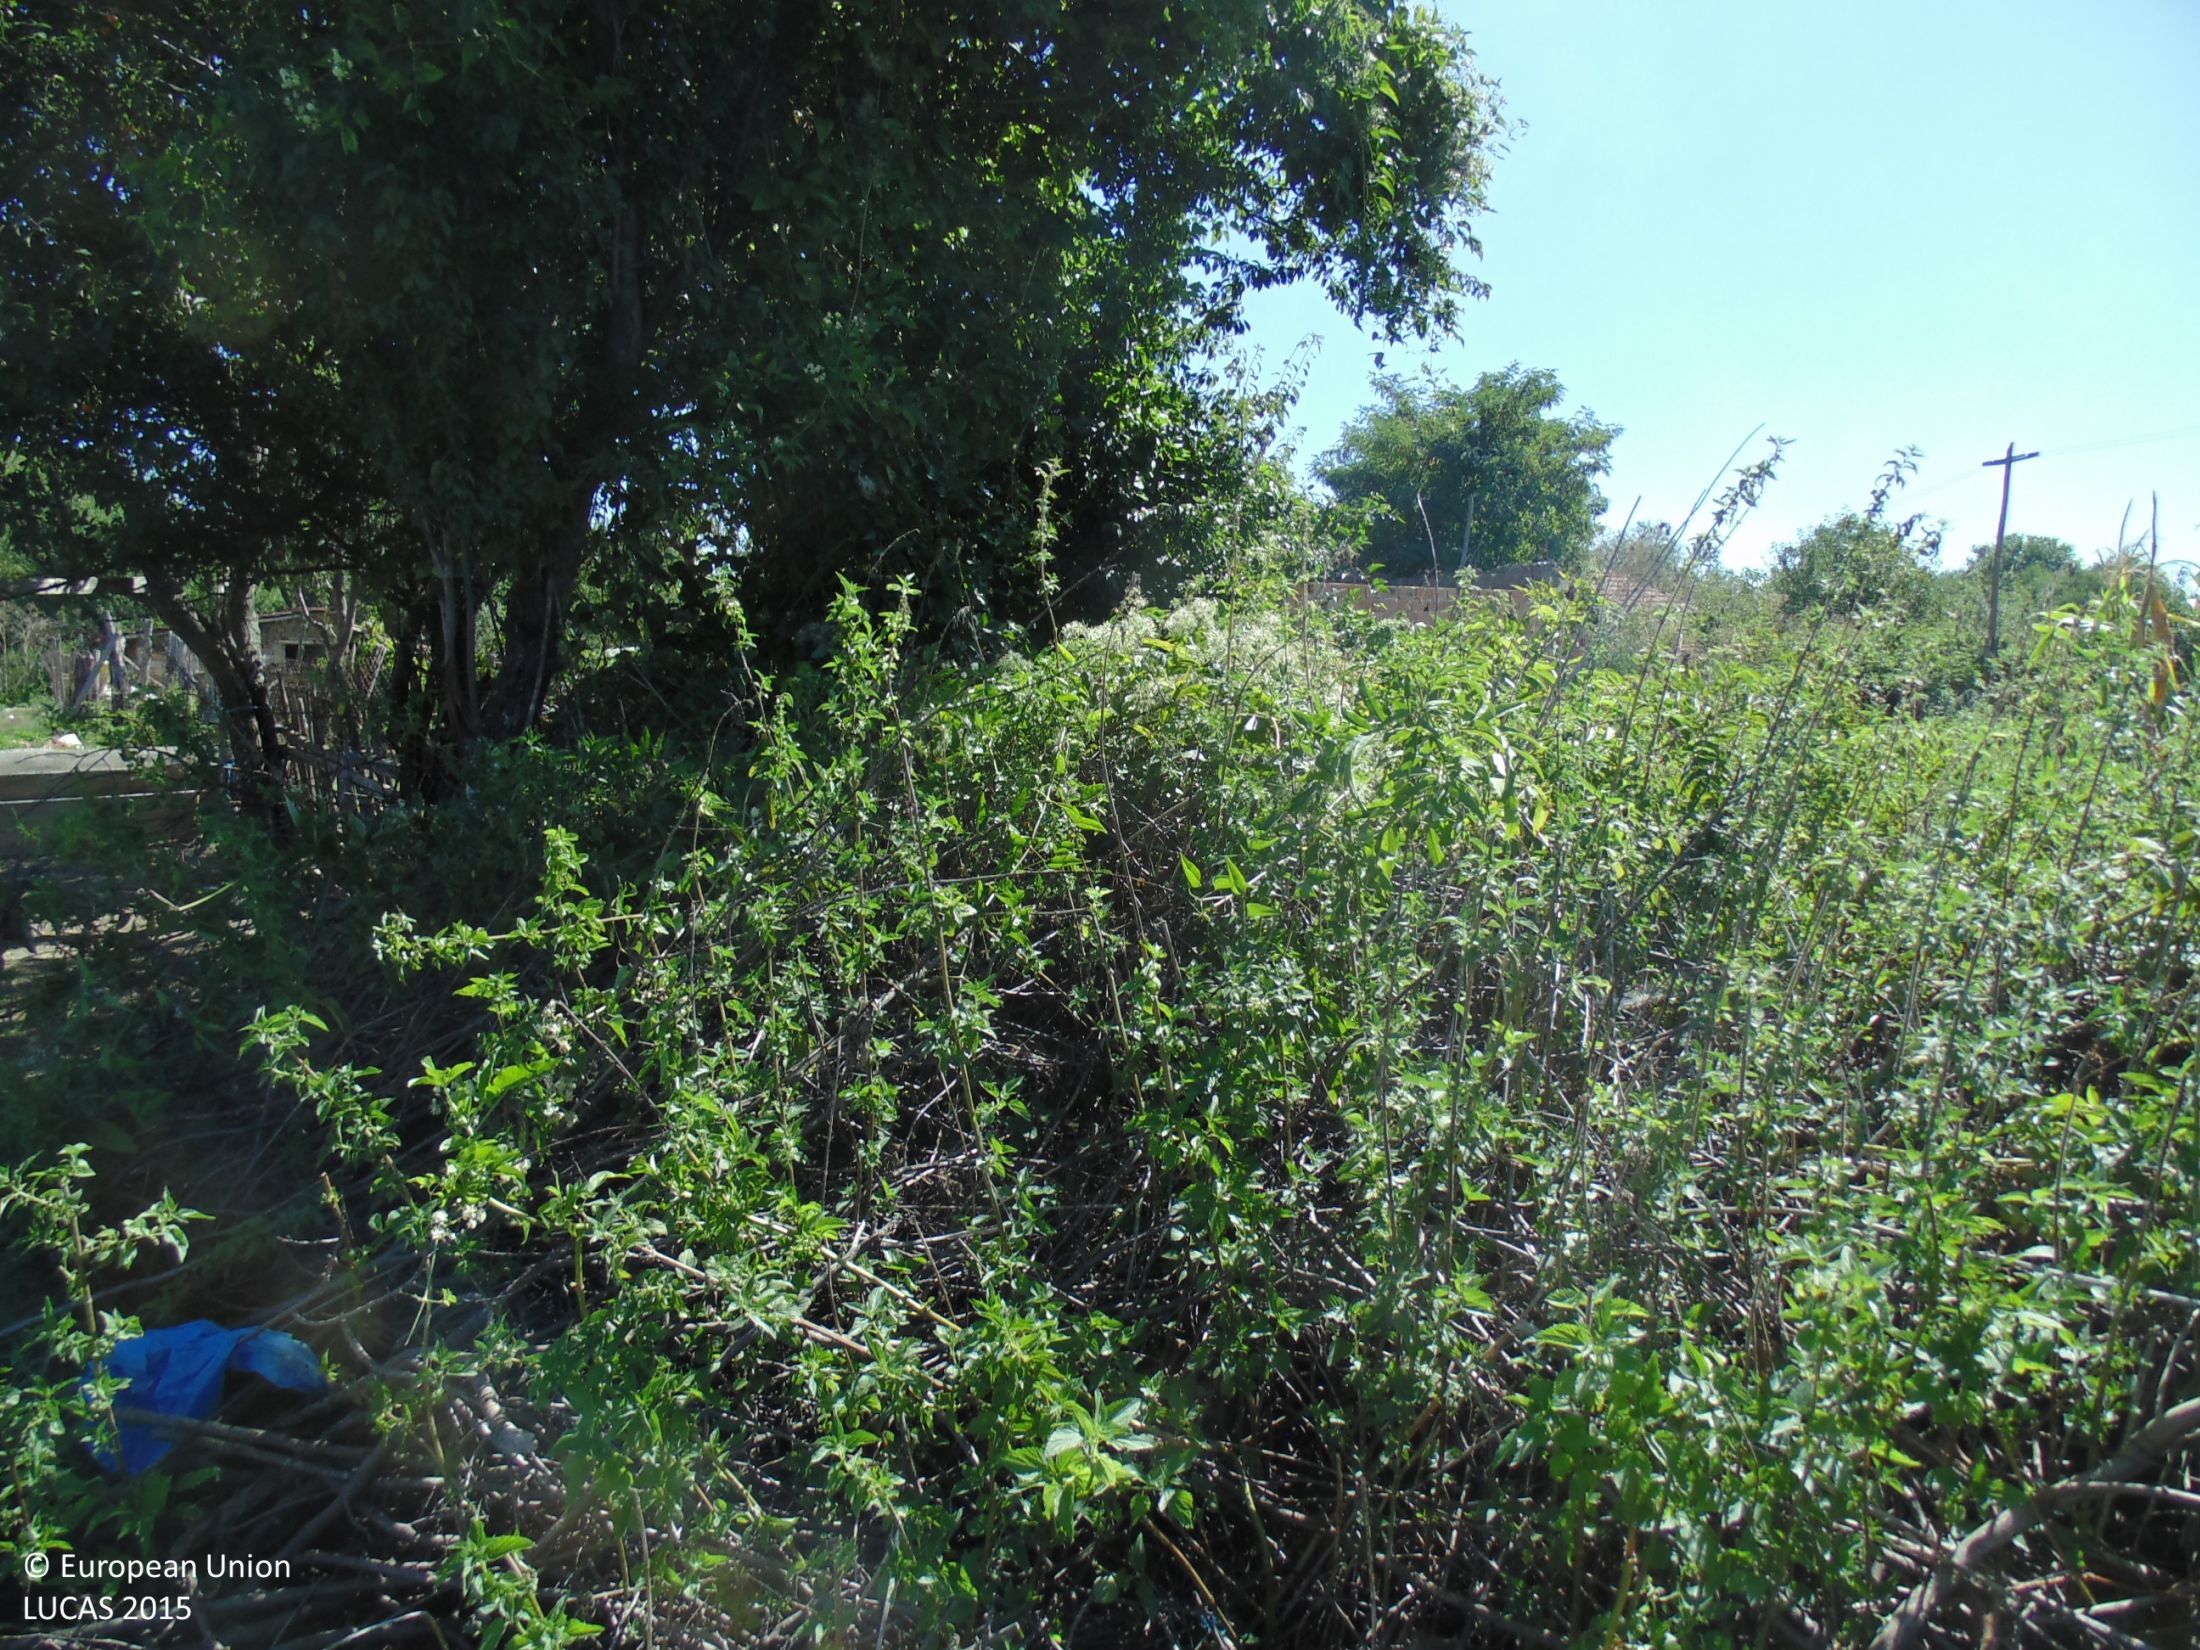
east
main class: Grassland
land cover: Grassland with sparse tree/shrub cover
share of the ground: > 75 %
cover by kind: herbaceous plants 90 %, broadleaved forest trees 5 %, shrubs 5 %
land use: Residential
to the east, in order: Grassland with sparse tree/shrub cover; Artificial constructions in urban areas; Shrubland with sparse tree cover; Artificial constructions in urban areas
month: September
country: BG
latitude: 43.8168
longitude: 27.1199
